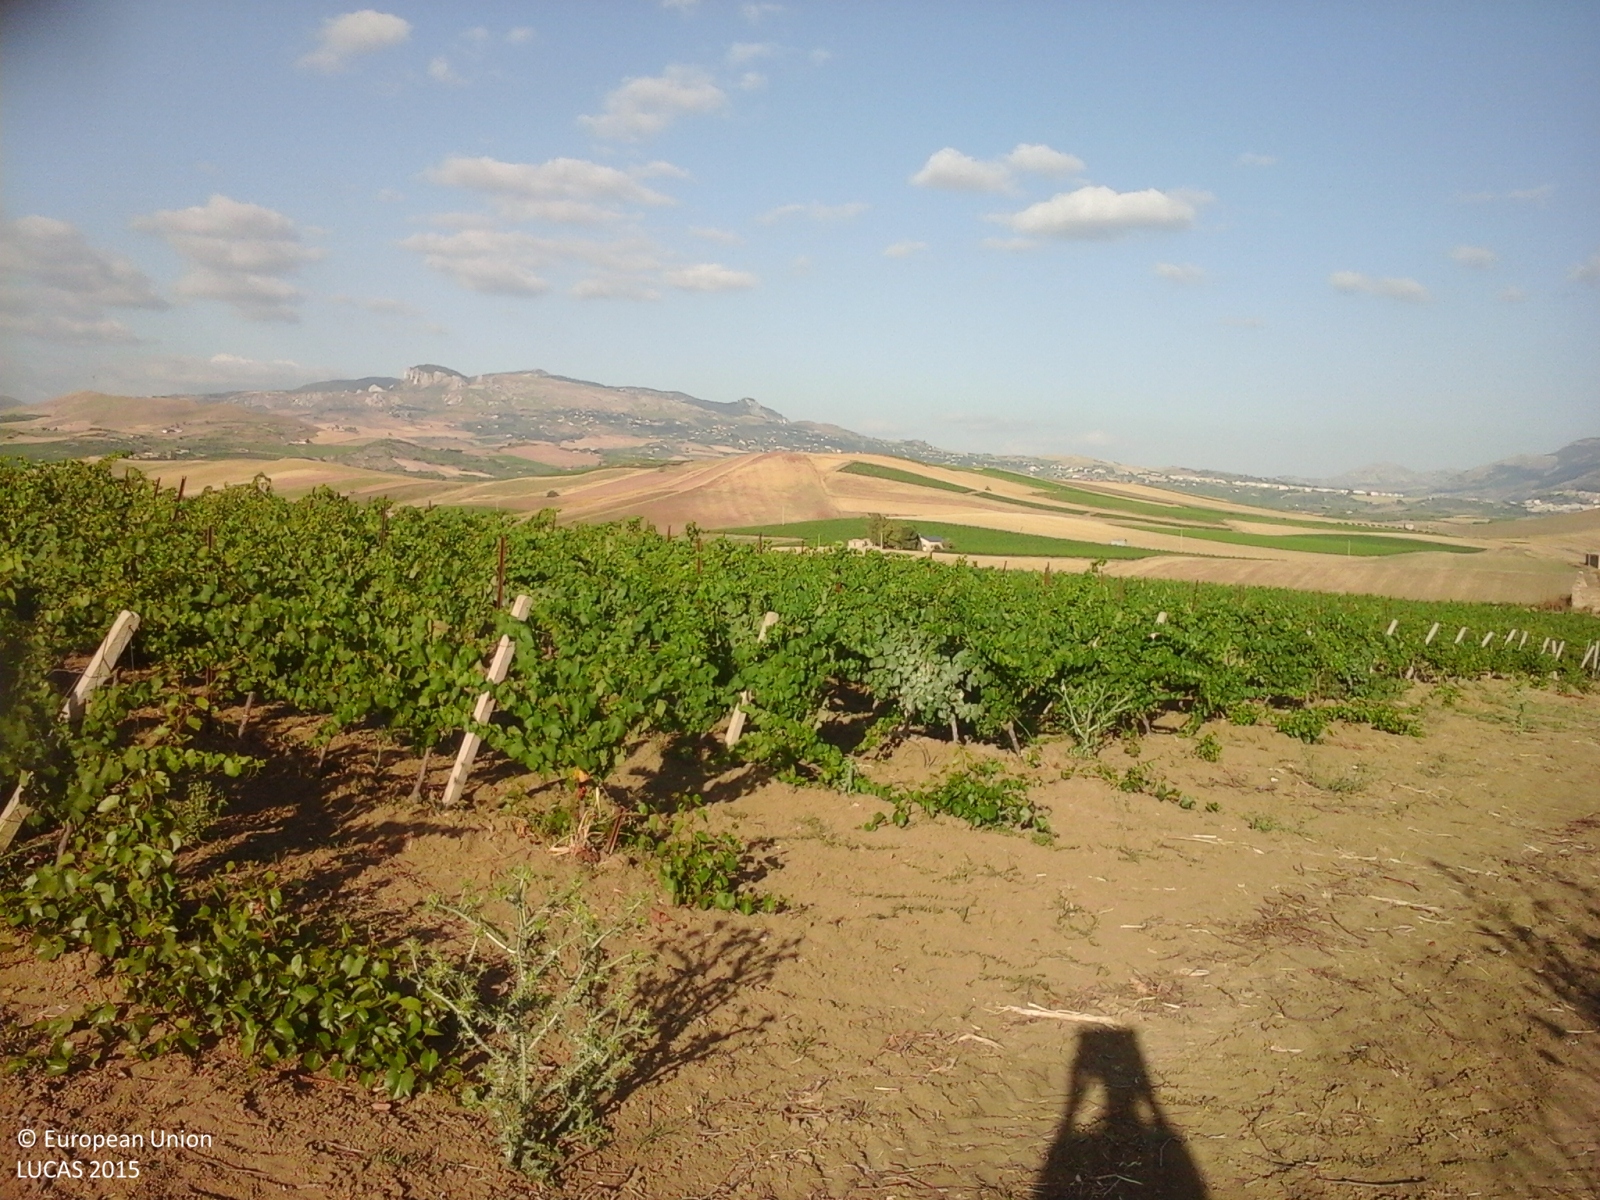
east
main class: Cropland
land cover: Durum wheat
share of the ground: > 75 %
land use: Agriculture (excluding fallow land and kitchen gardens)
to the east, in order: Durum wheat; Fences; Other bare soil; Vineyards; Other bare soil; Durum wheat
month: June
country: IT
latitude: 37.6805
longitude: 13.0499
